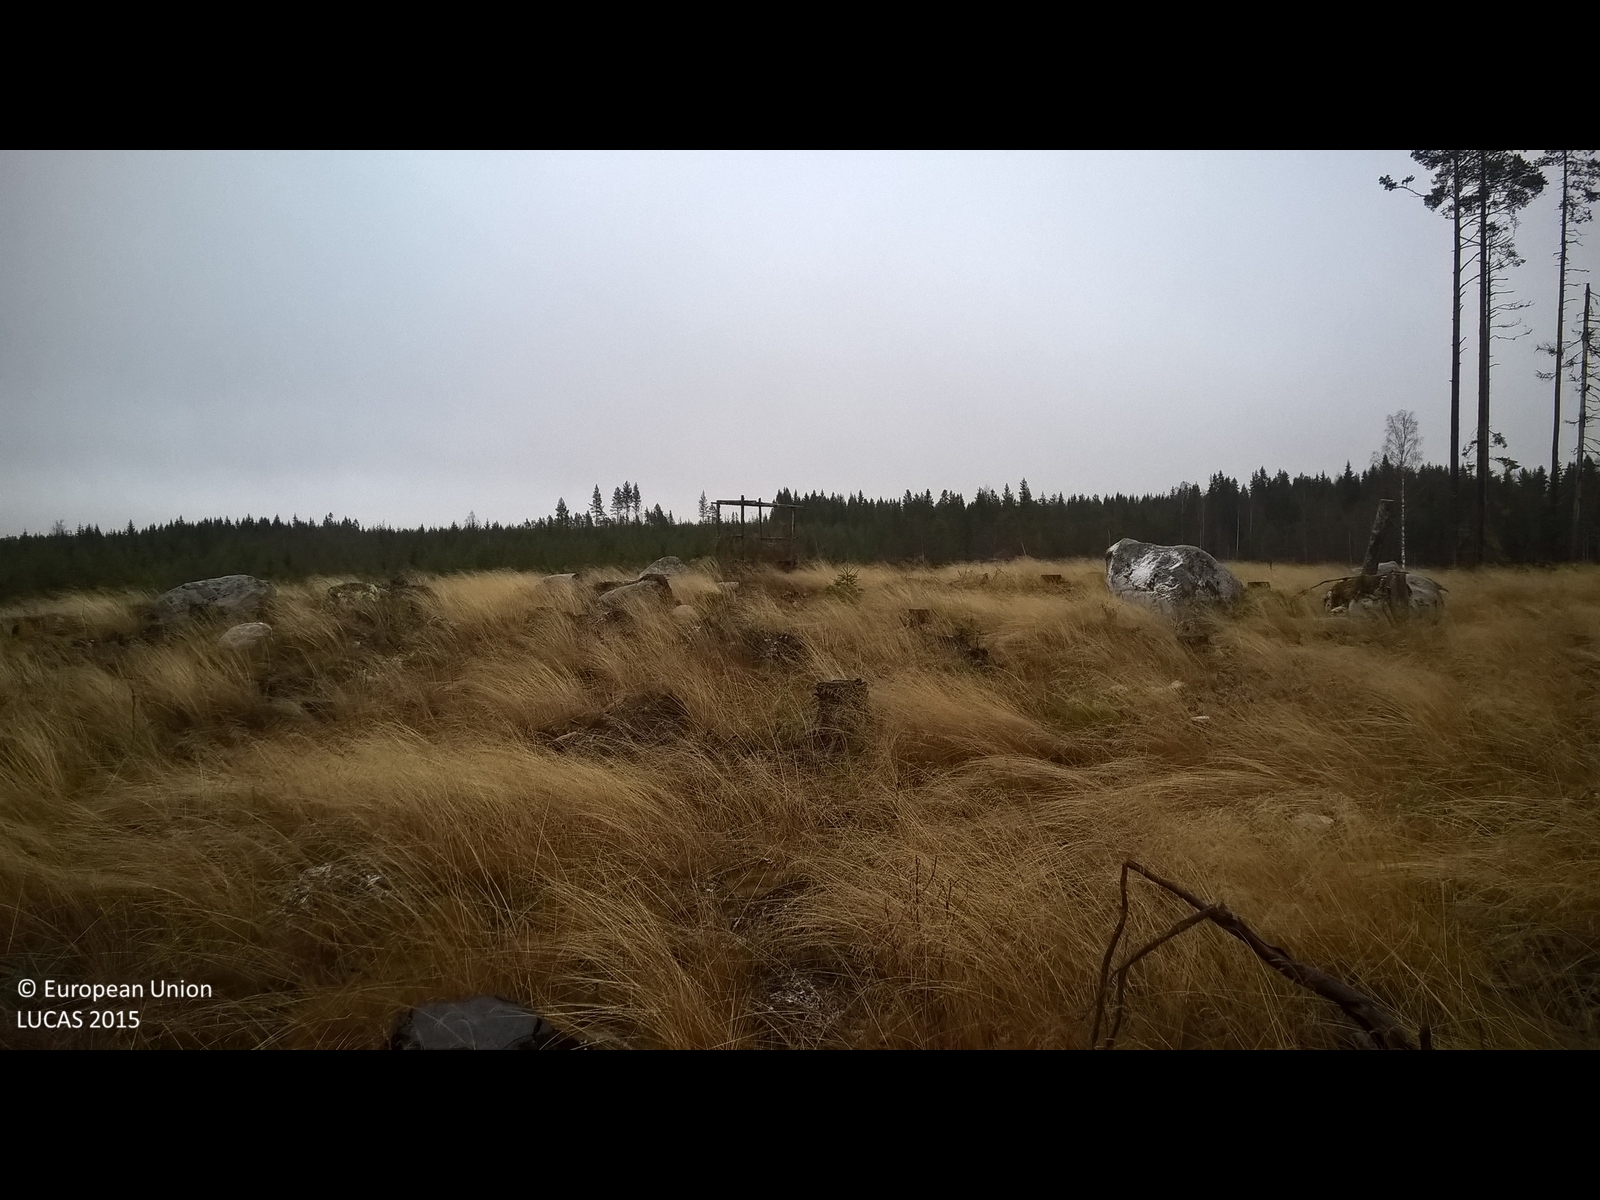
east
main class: Grassland
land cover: Grassland with sparse tree/shrub cover
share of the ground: > 75 %
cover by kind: herbaceous plants 75 %, shrubs 10 %, lichens and mosses 10 %, coniferous forest trees 5 %
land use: Forestry
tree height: < 5 m
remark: Clear cut
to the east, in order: Grassland with sparse tree/shrub cover; Spruce dominated coniferous woodland; Ditches and canals; Other mixed woodland
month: November
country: SE
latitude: 60.4404
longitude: 14.8400
